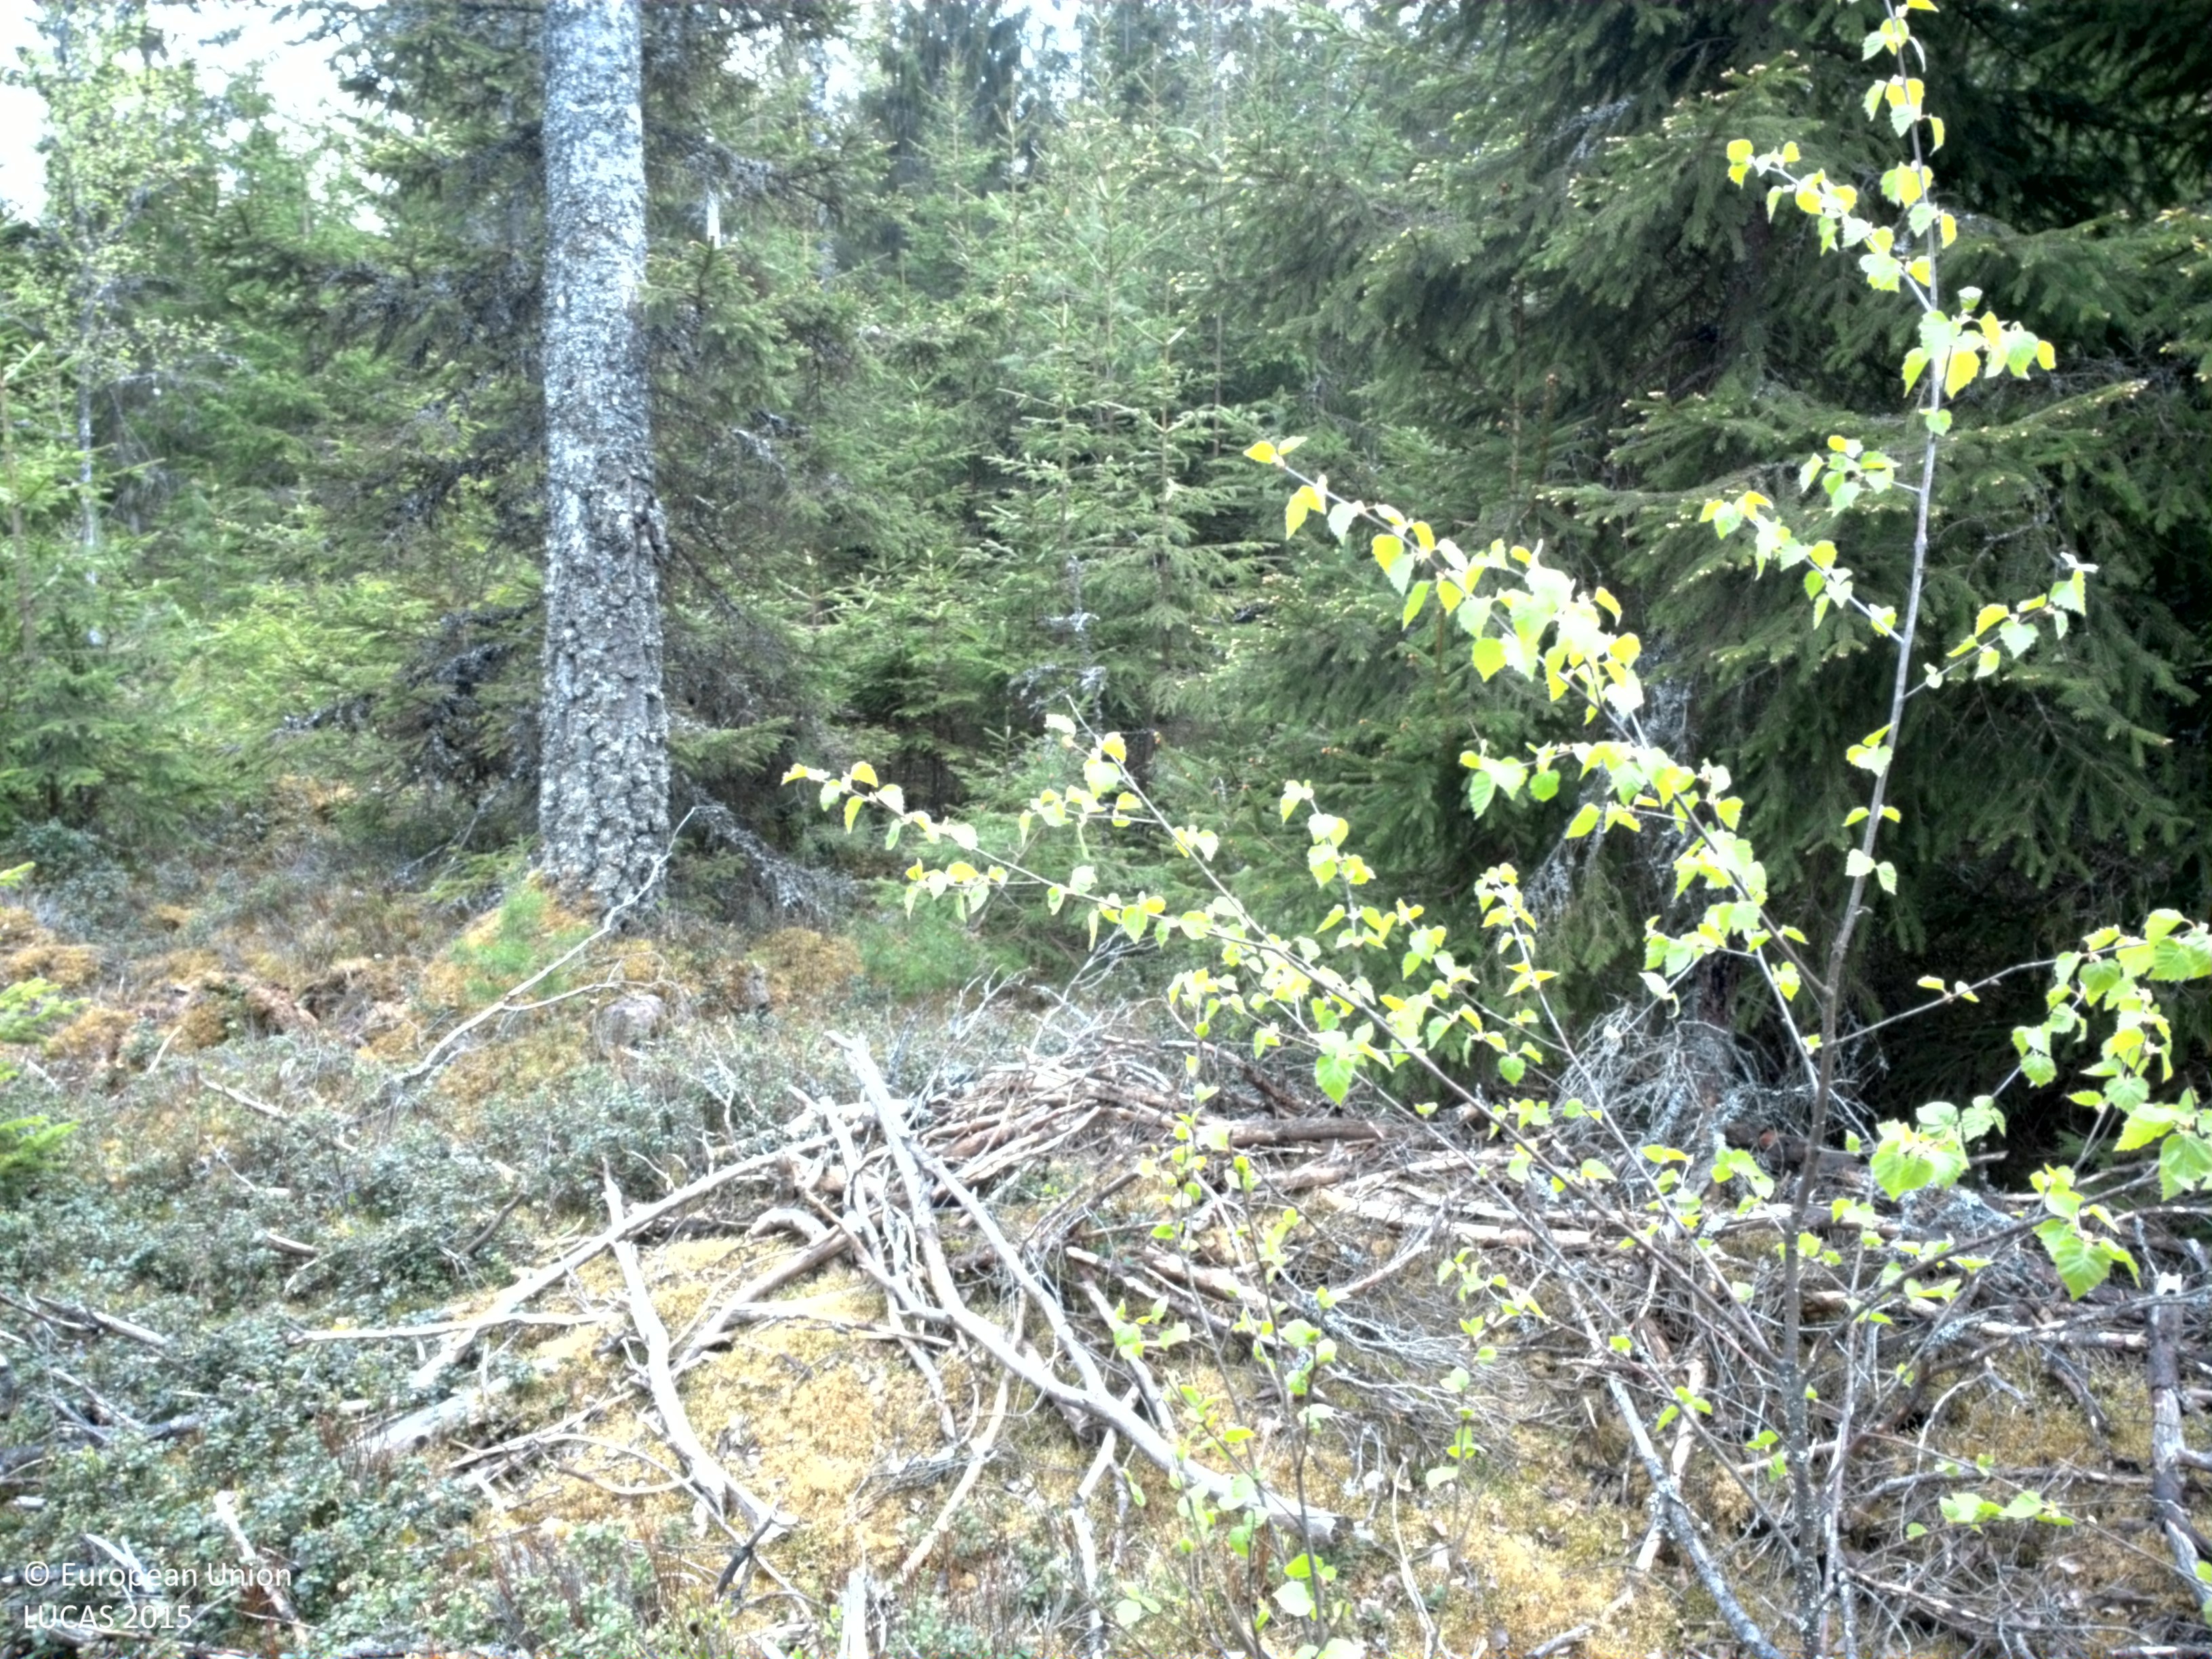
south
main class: Woodland
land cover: Broadleaved woodland
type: boreal forest
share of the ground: 50 - 75 %
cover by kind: broadleaved forest trees 55 %, shrubs 15 %, coniferous forest trees 10 %, herbaceous plants 10 %, lichens and mosses 10 %
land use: Forestry
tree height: < 5 m
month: May
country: SE
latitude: 56.7599
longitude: 15.3798
